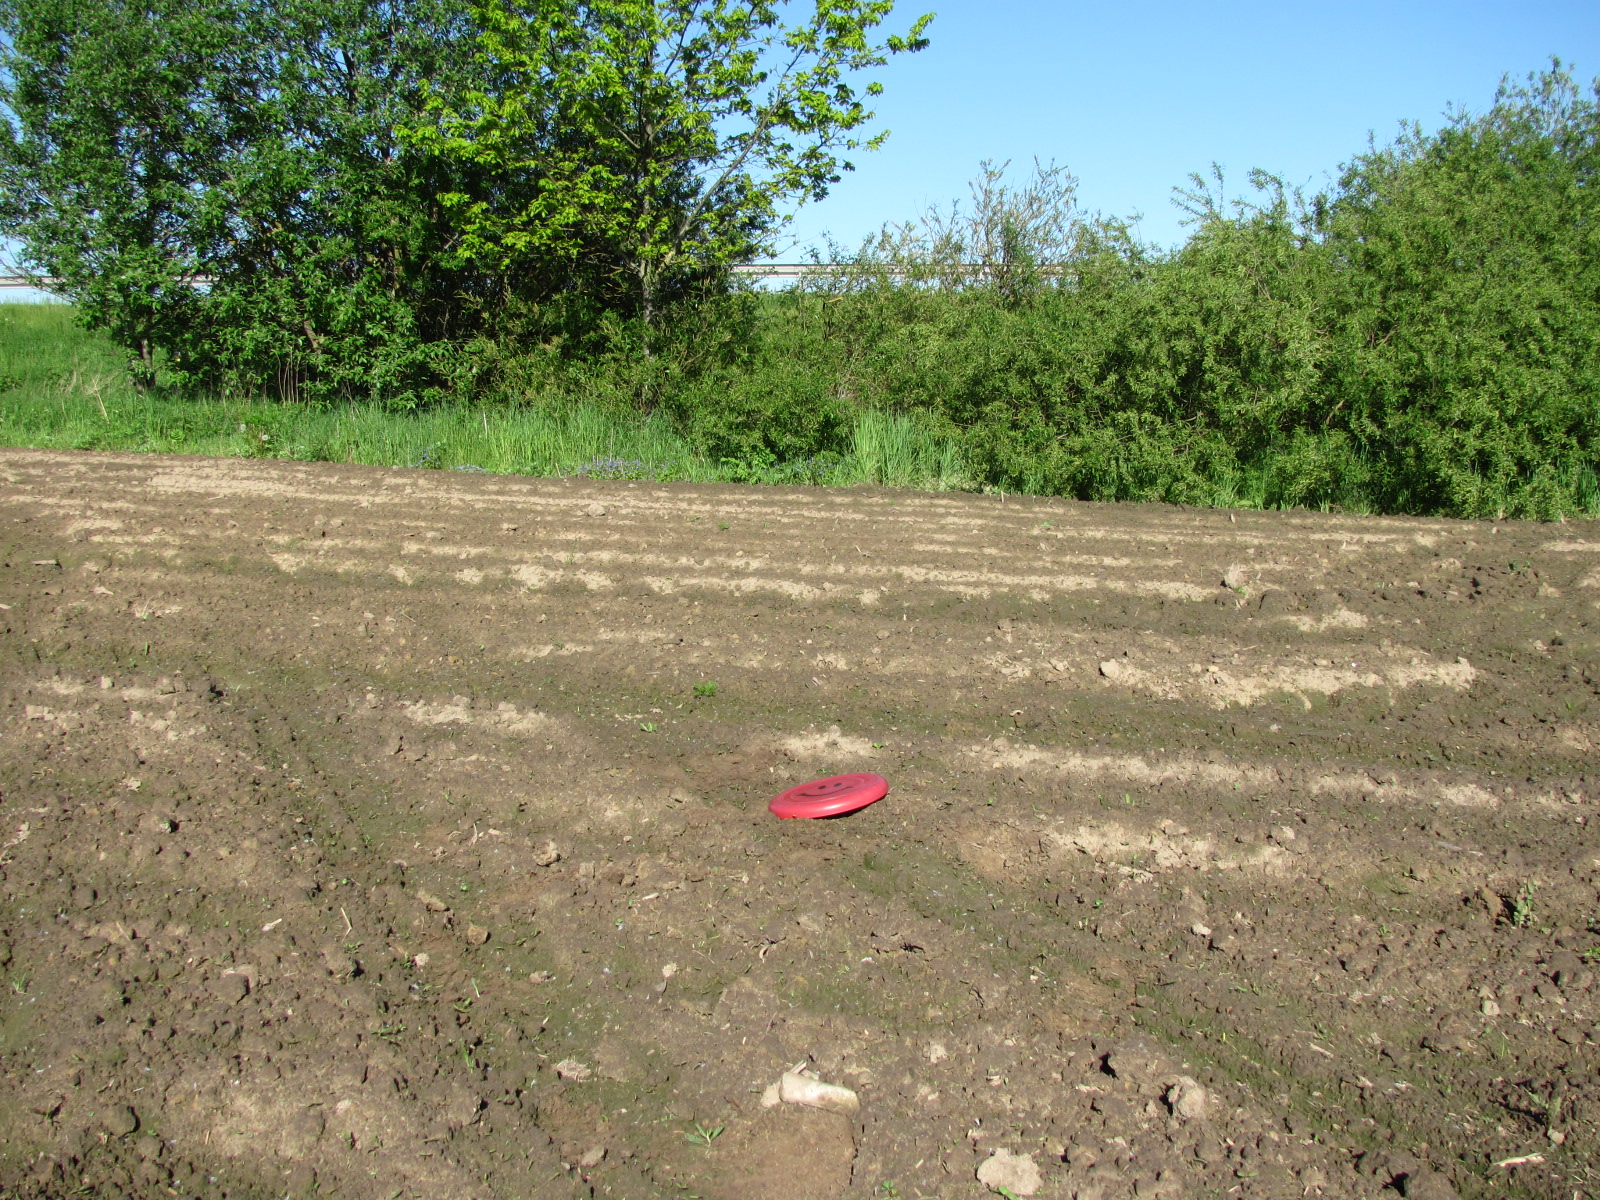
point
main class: Cropland
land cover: Maize
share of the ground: < 10 %
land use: Agriculture (excluding fallow land and kitchen gardens)
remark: Tilled/Sowed
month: May
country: LV
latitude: 56.6162
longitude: 24.2172
